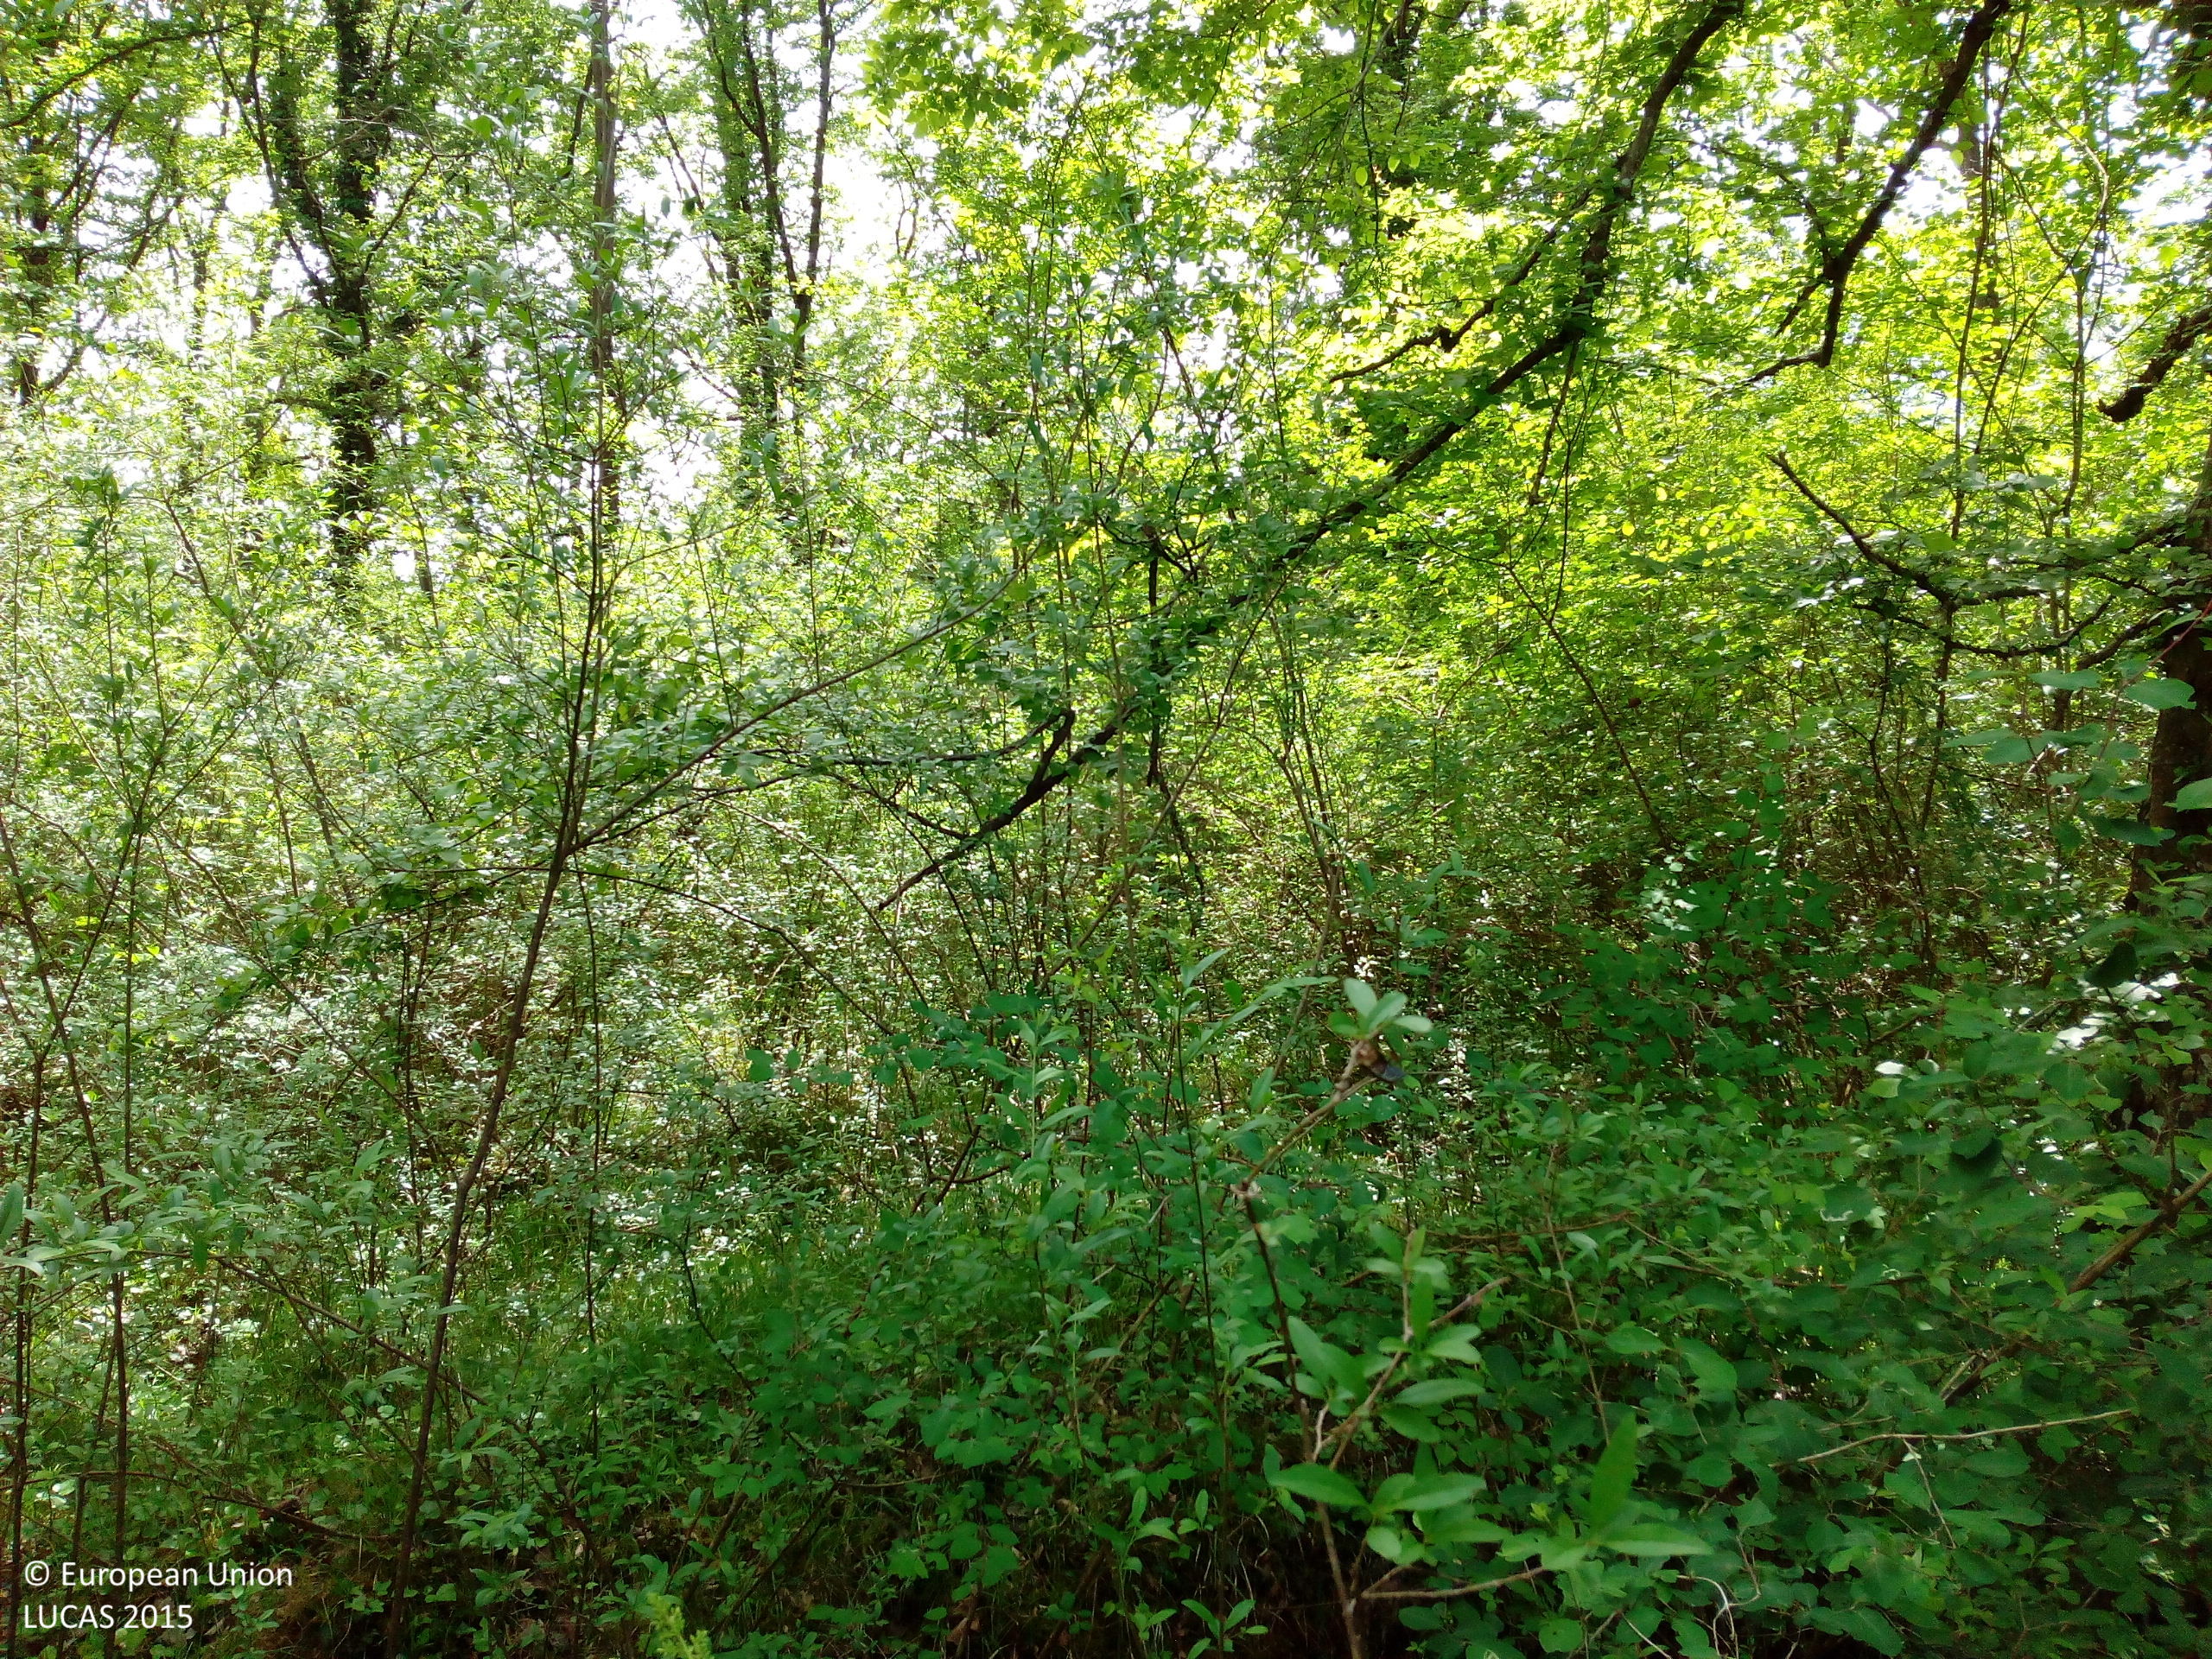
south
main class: Woodland
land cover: Broadleaved woodland
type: floodplain forest
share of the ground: > 75 %
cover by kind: broadleaved forest trees 85 %, shrubs 10 %, herbaceous plants 5 %
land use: Forestry
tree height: > 5 m
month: May
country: DE
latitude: 47.9455
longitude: 7.6047
